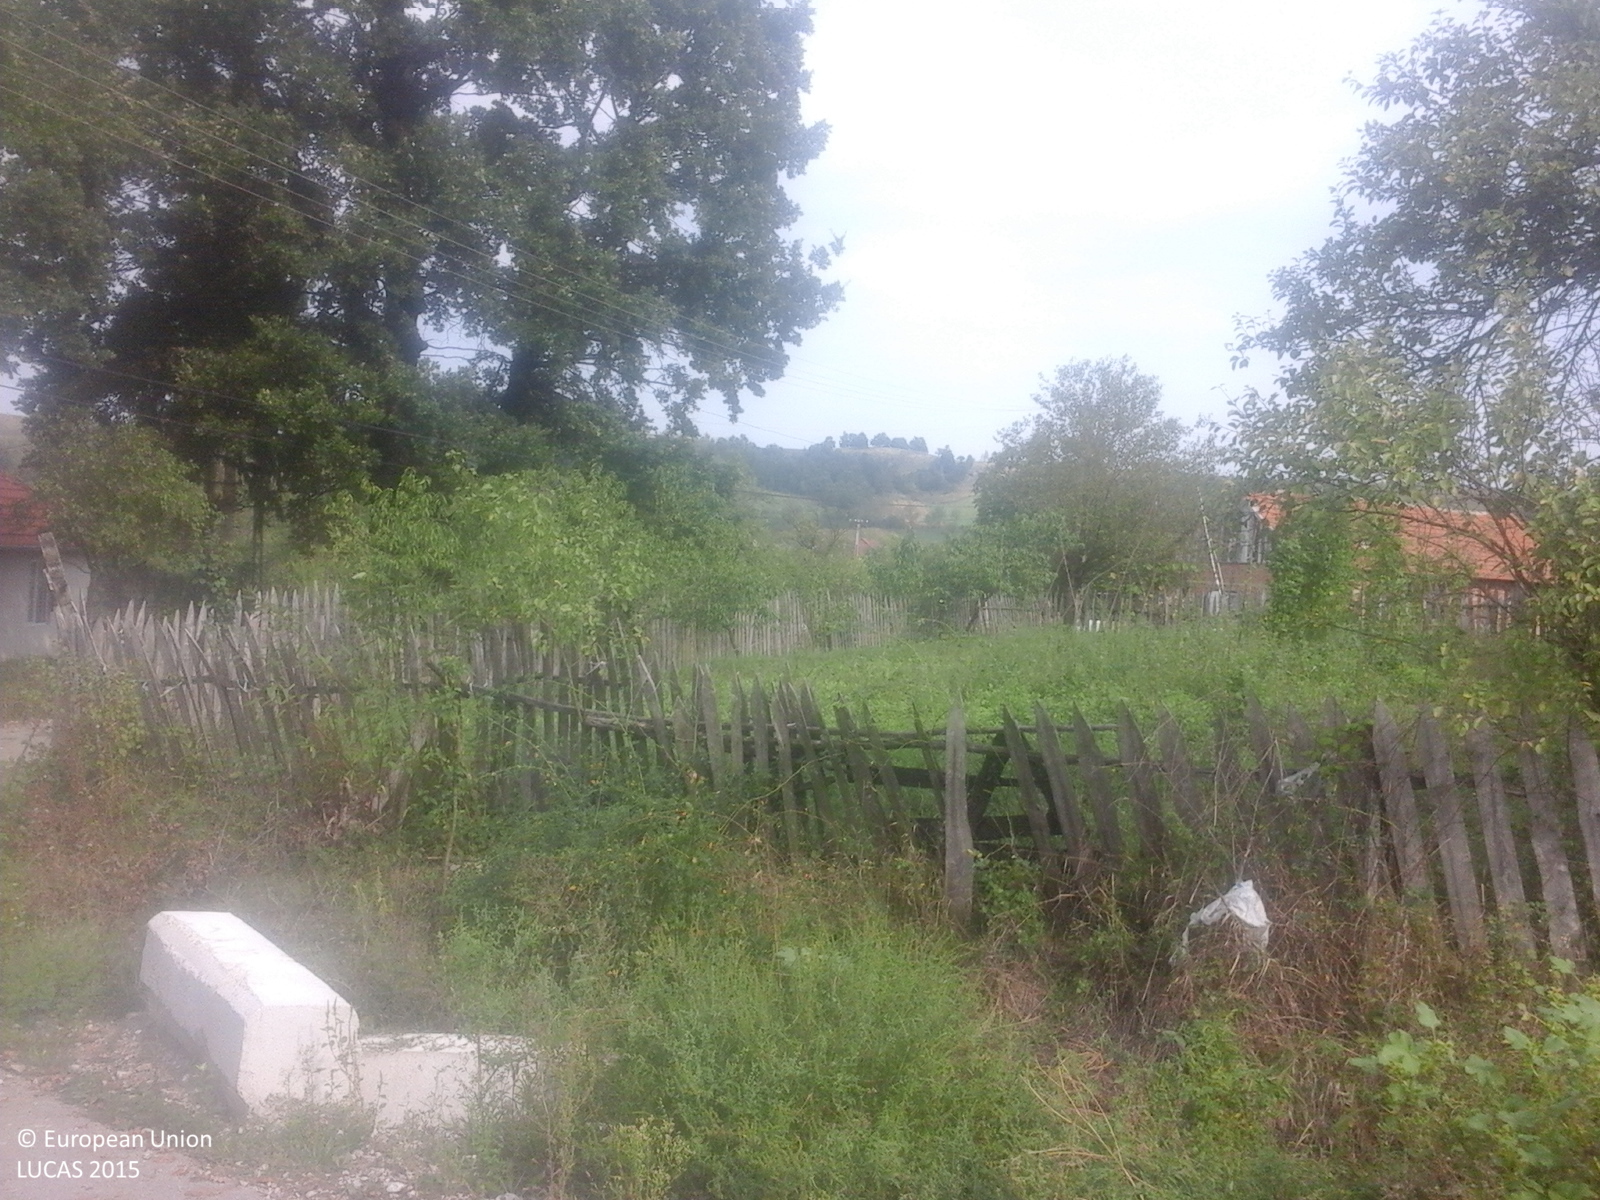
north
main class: Cropland
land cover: Other fruit trees and berries
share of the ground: 50 - 75 %
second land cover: Grassland without tree/shrub cover
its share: > 75 %
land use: Agriculture (excluding fallow land and kitchen gardens)
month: September
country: RO
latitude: 45.6856
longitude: 23.1141
